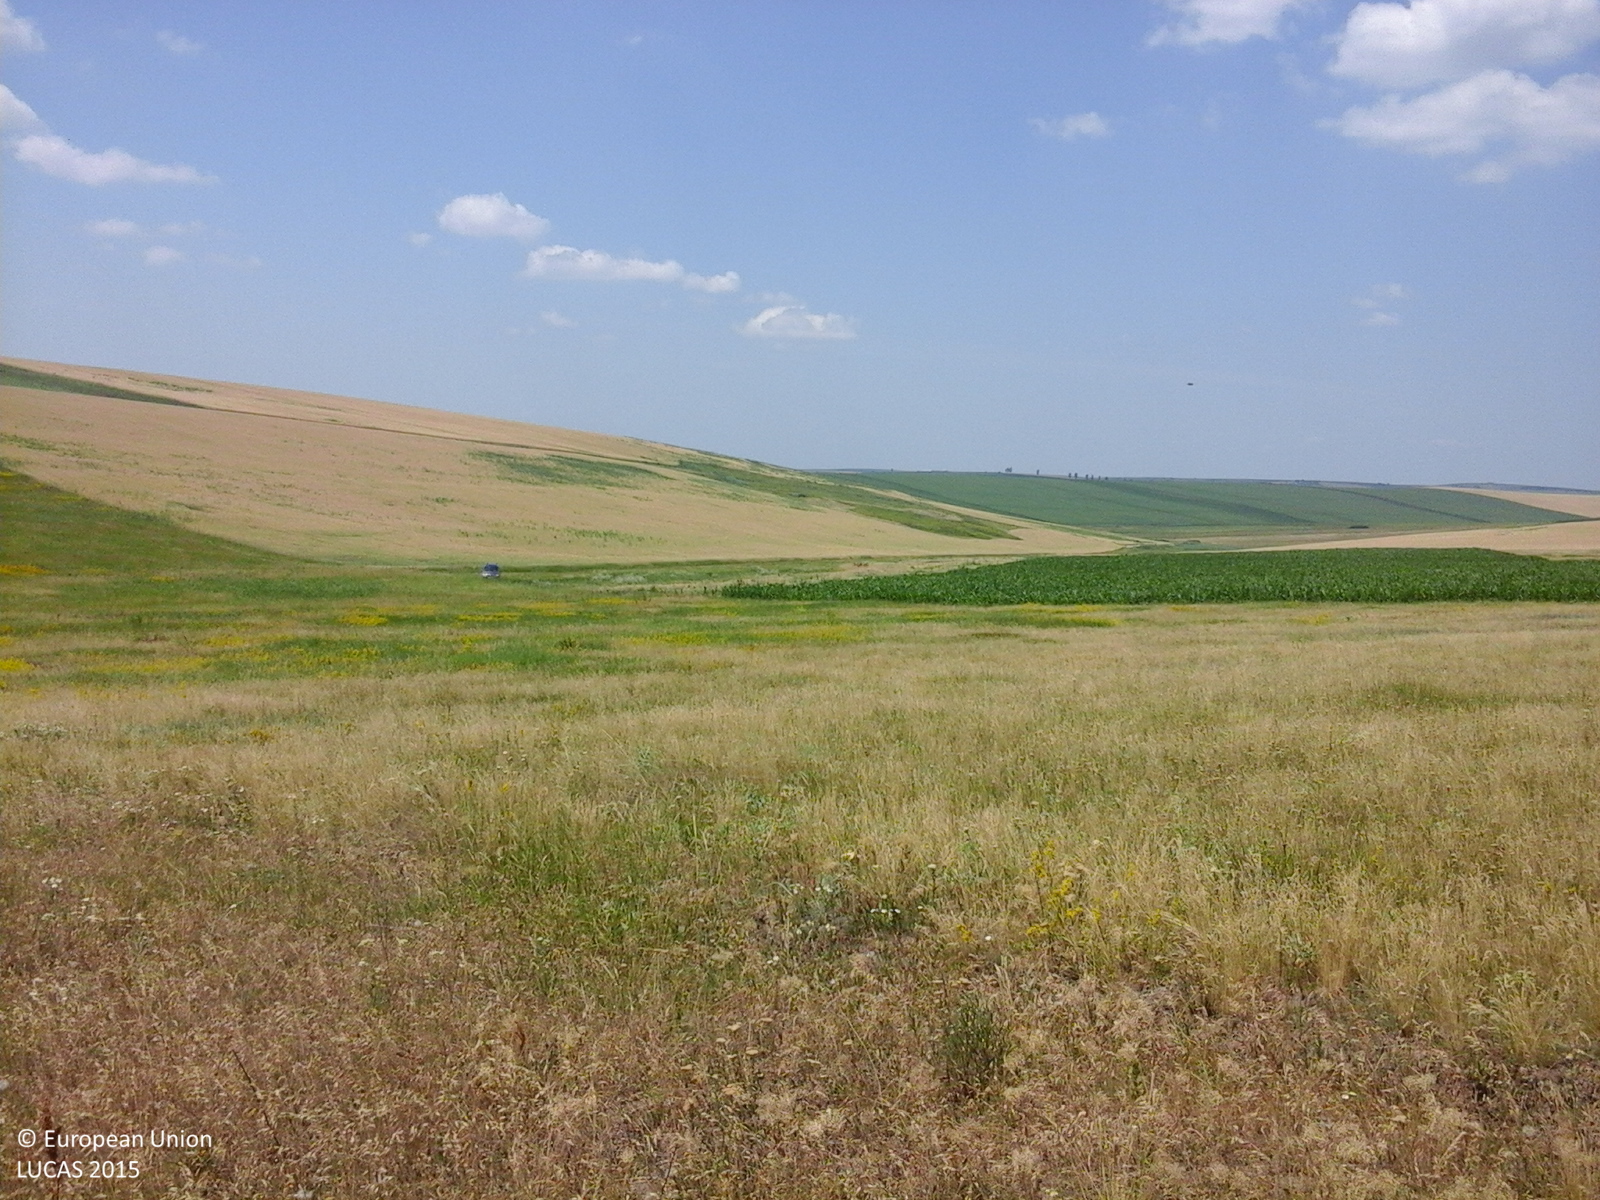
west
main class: Grassland
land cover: Grassland without tree/shrub cover
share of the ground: > 75 %
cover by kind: herbaceous plants 100 %
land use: Agriculture (excluding fallow land and kitchen gardens)
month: June
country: RO
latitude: 47.2383
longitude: 27.3507
